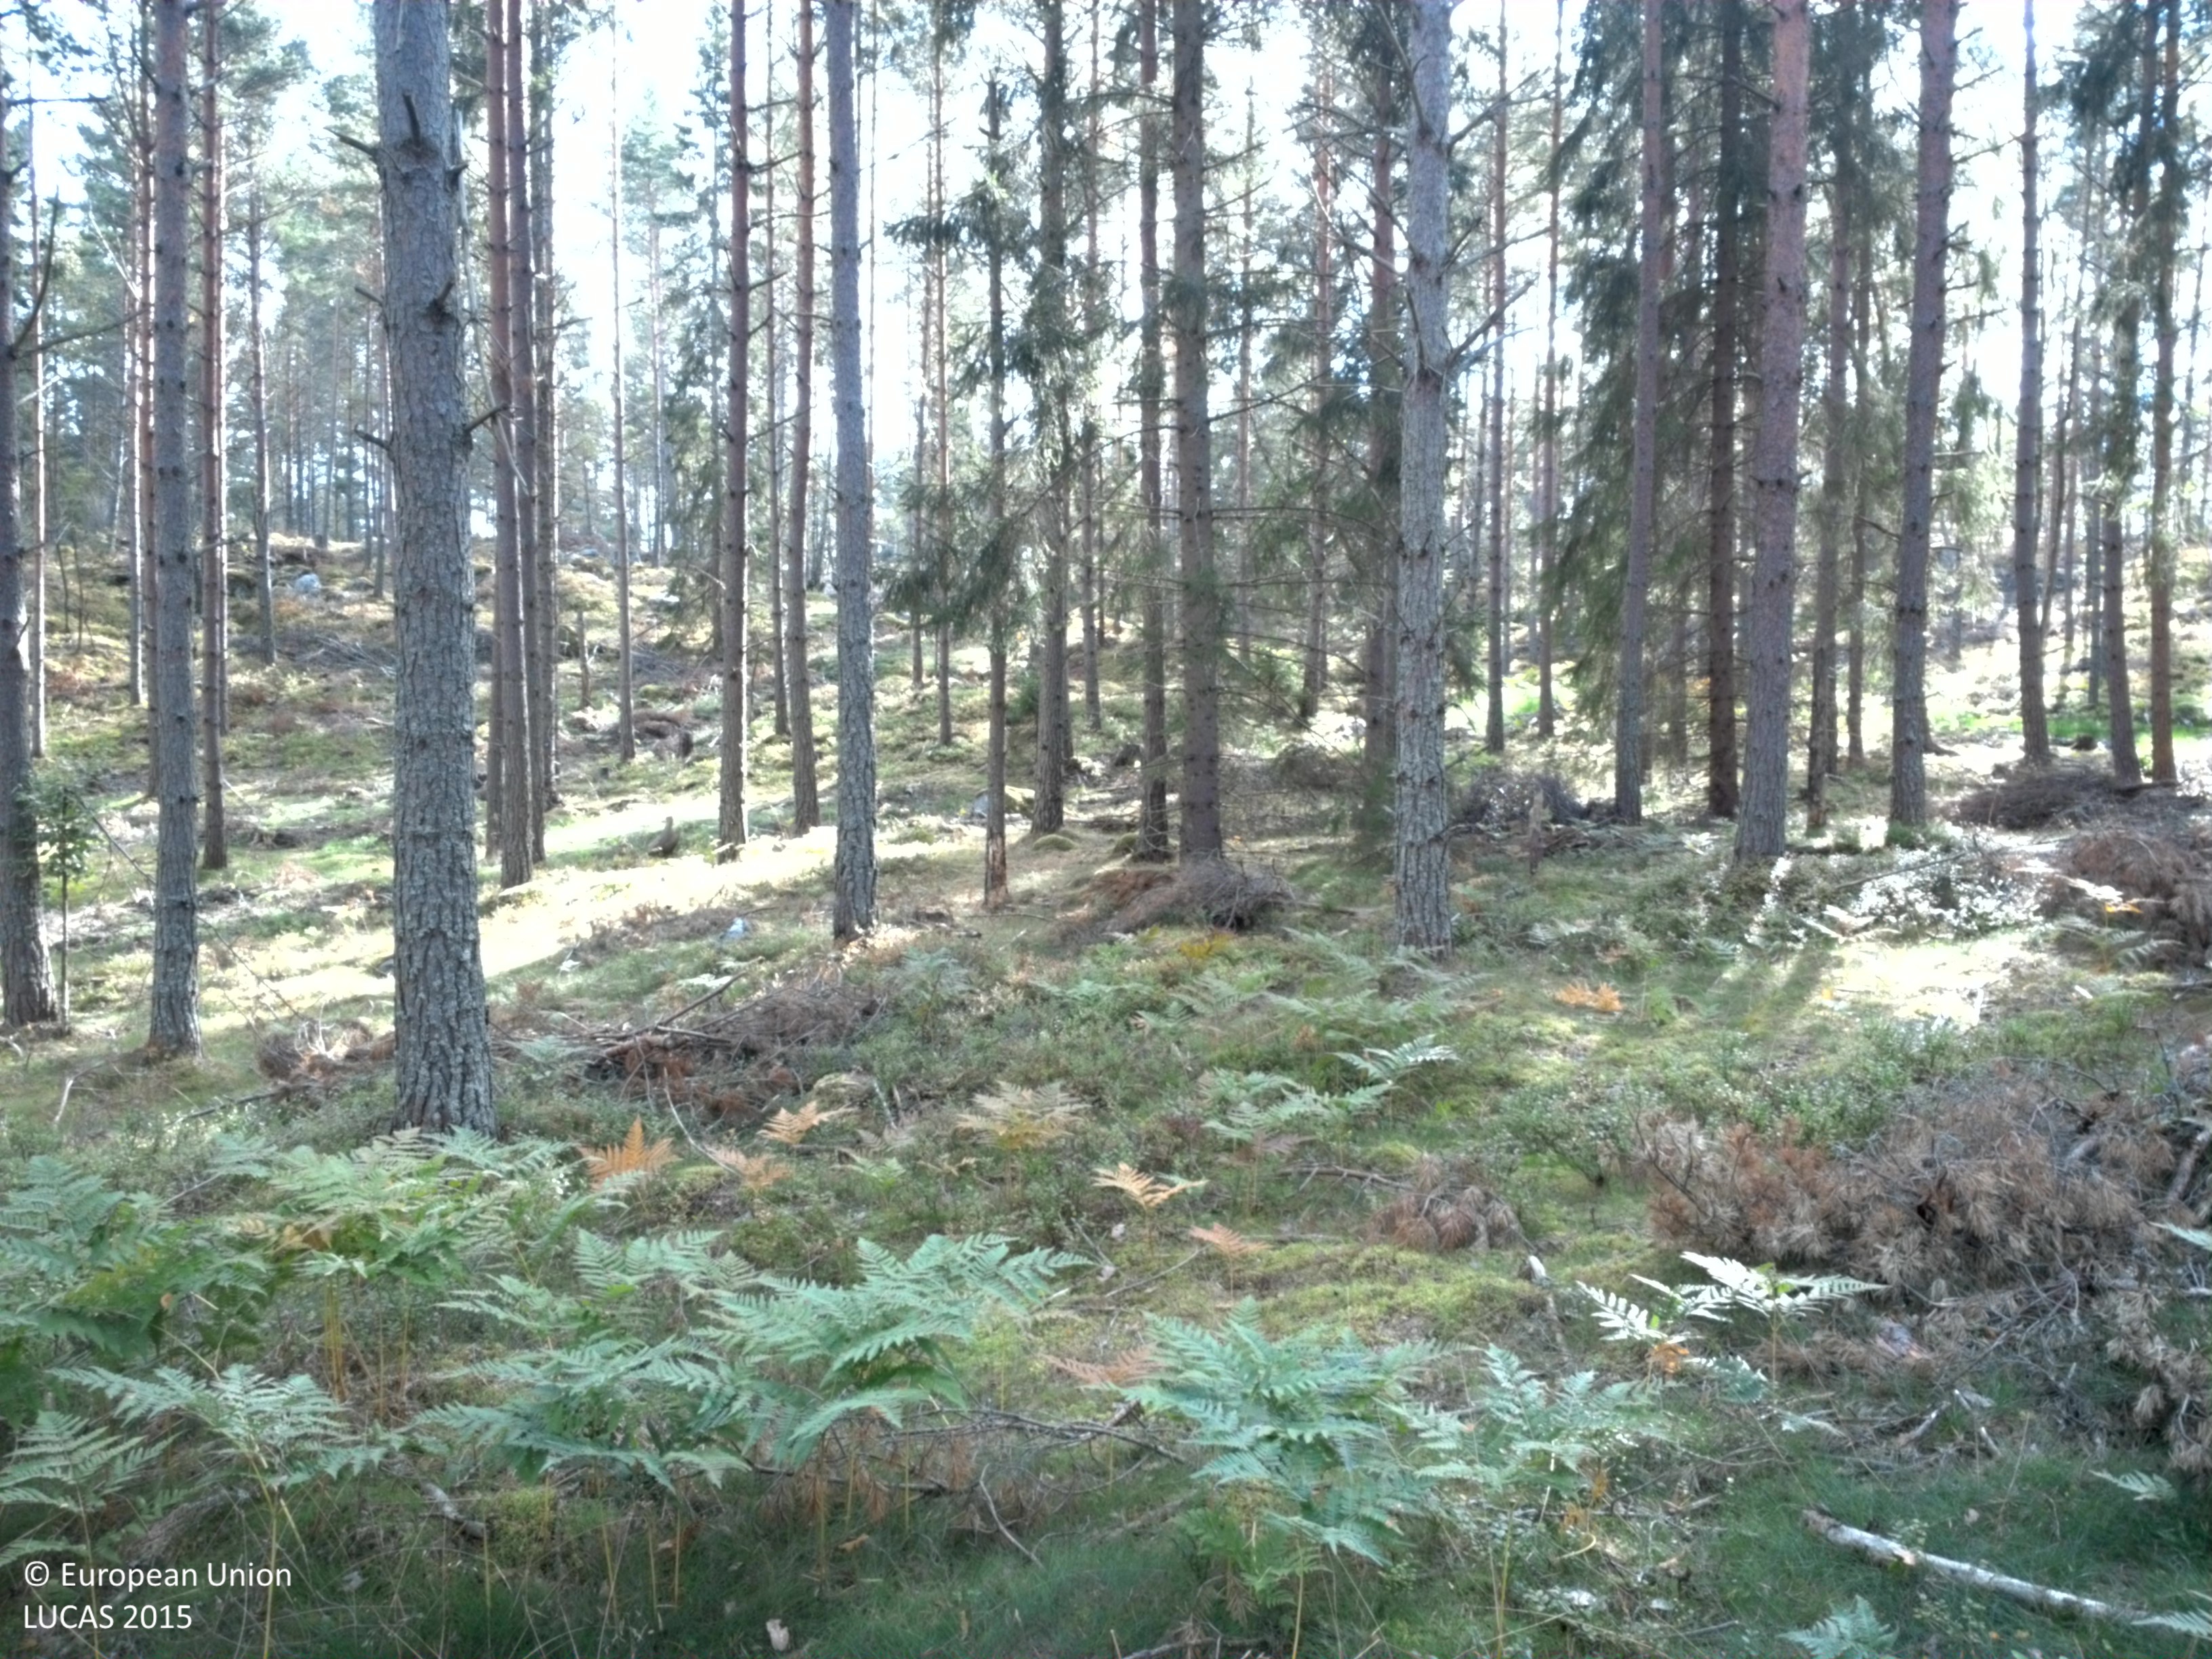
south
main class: Woodland
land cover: Pine dominated coniferous woodland
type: boreal forest
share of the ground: 50 - 75 %
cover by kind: coniferous forest trees 60 %, herbaceous plants 20 %, lichens and mosses 20 %
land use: Forestry
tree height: > 5 m
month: September
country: SE
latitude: 59.3625
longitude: 18.4981
